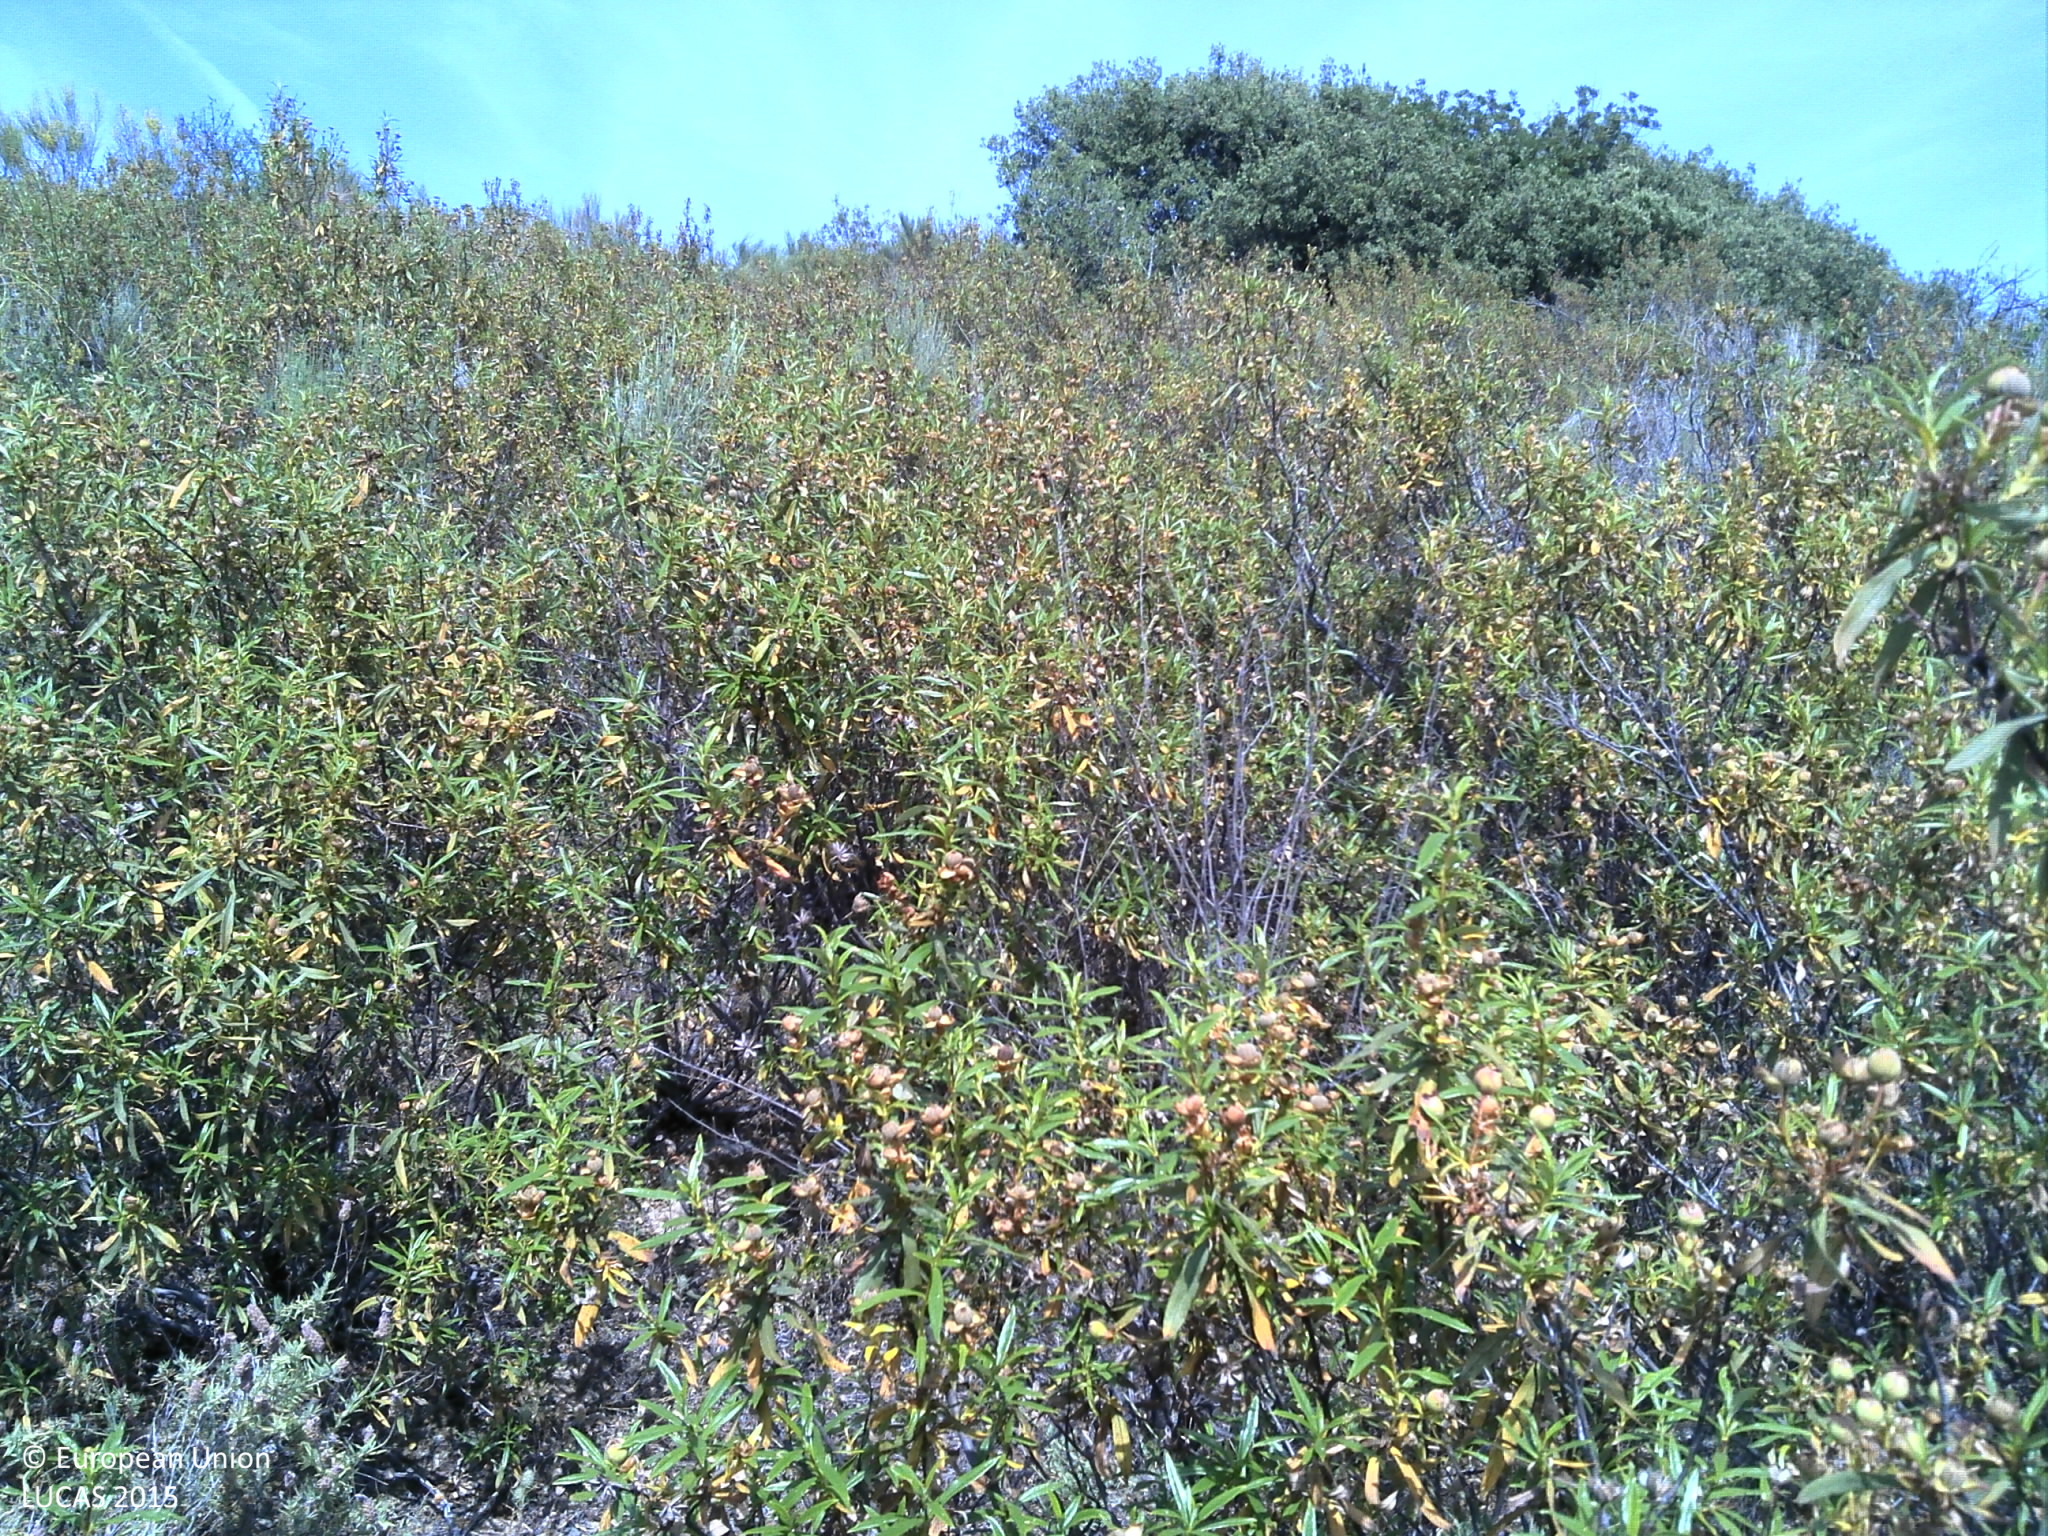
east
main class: Shrubland
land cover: Shrubland with sparse tree cover
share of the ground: 50 - 75 %
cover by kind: shrubs 75 %, unconsolidated bare surface 15 %, broadleaved forest trees 5 %, herbaceous plants 5 %
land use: Abandoned areas
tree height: < 5 m
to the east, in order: Shrubland with sparse tree cover; Groves; Shrubland without tree cover; Shrubland with sparse tree cover; Shrubland without tree cover; Tracks; Shrubland without tree cover; Shrubland with sparse tree cover; Tracks; Shrubland without tree cover; Tracks; Shrubland with sparse tree cover; Shrubland without tree cover
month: May
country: PT
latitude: 41.2327
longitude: -6.9431
